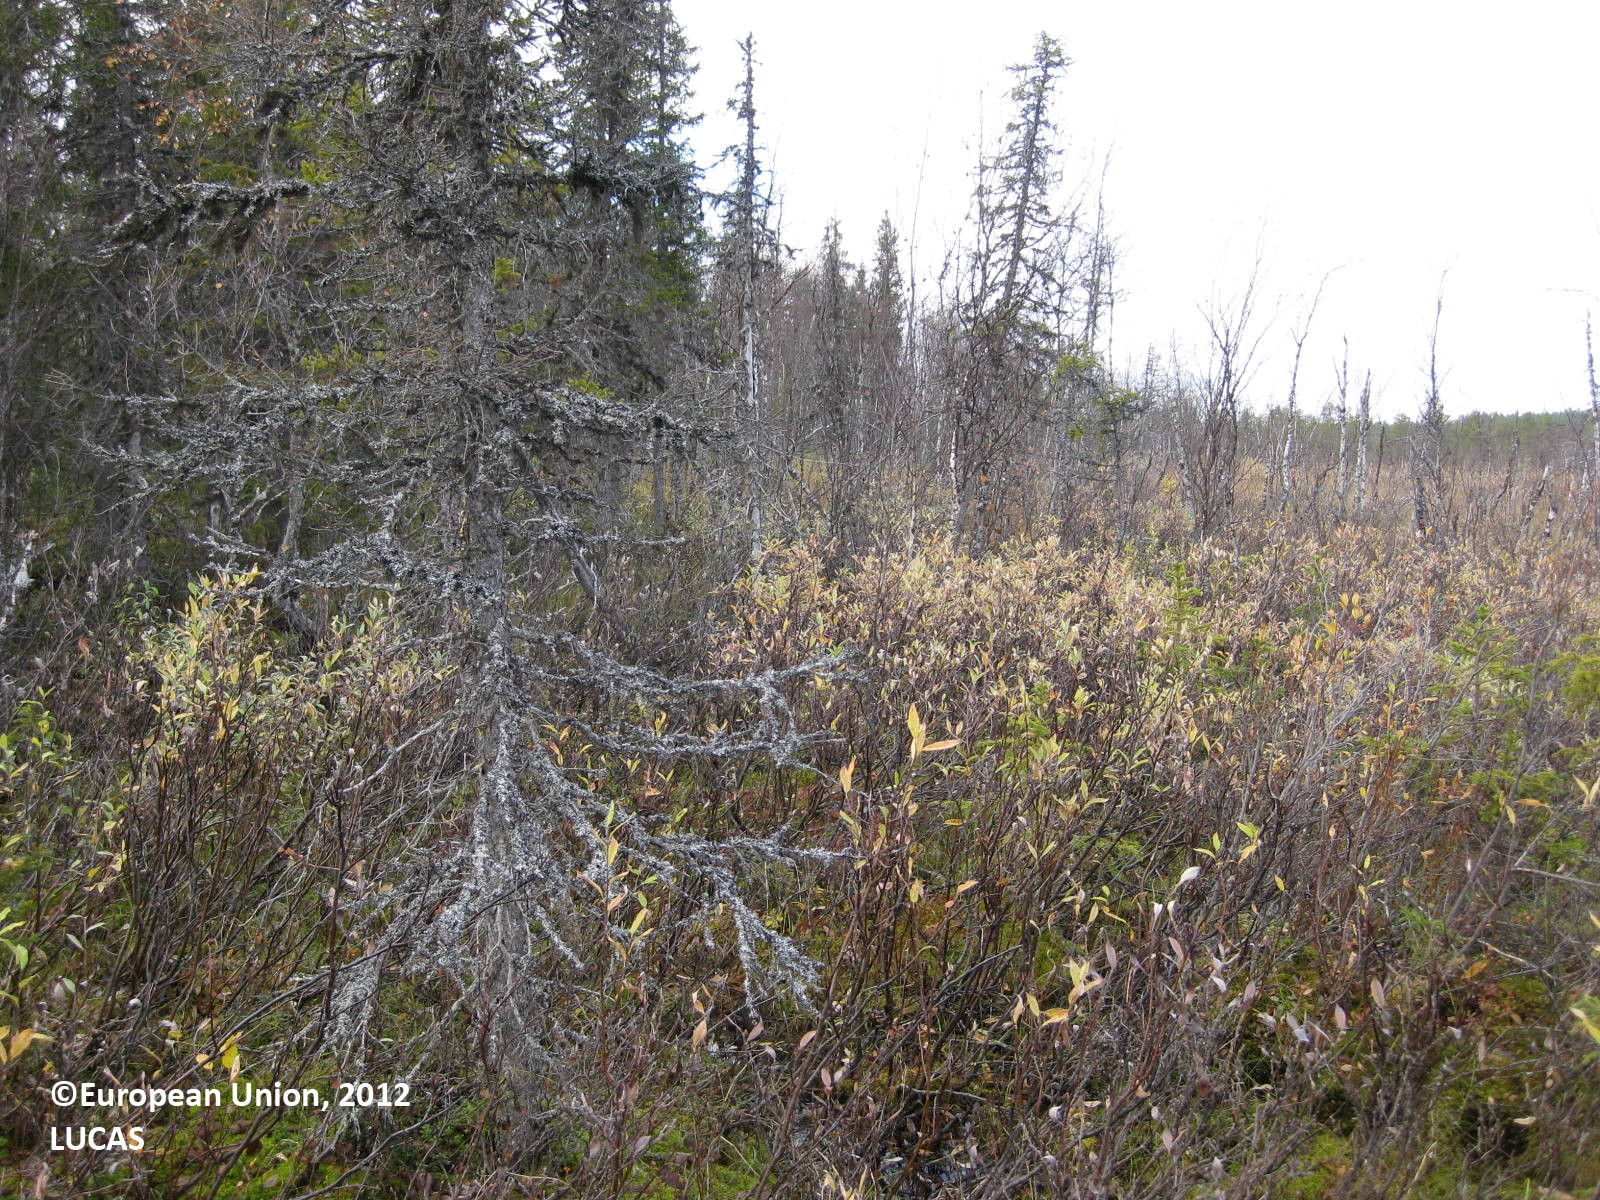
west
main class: Woodland
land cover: Pine dominated mixed woodland
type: boreal forest
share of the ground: 25 - 50 %
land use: Semi-natural and natural areas not in use
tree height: > 5 m
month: September
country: FI
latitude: 67.9908
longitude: 23.6163
